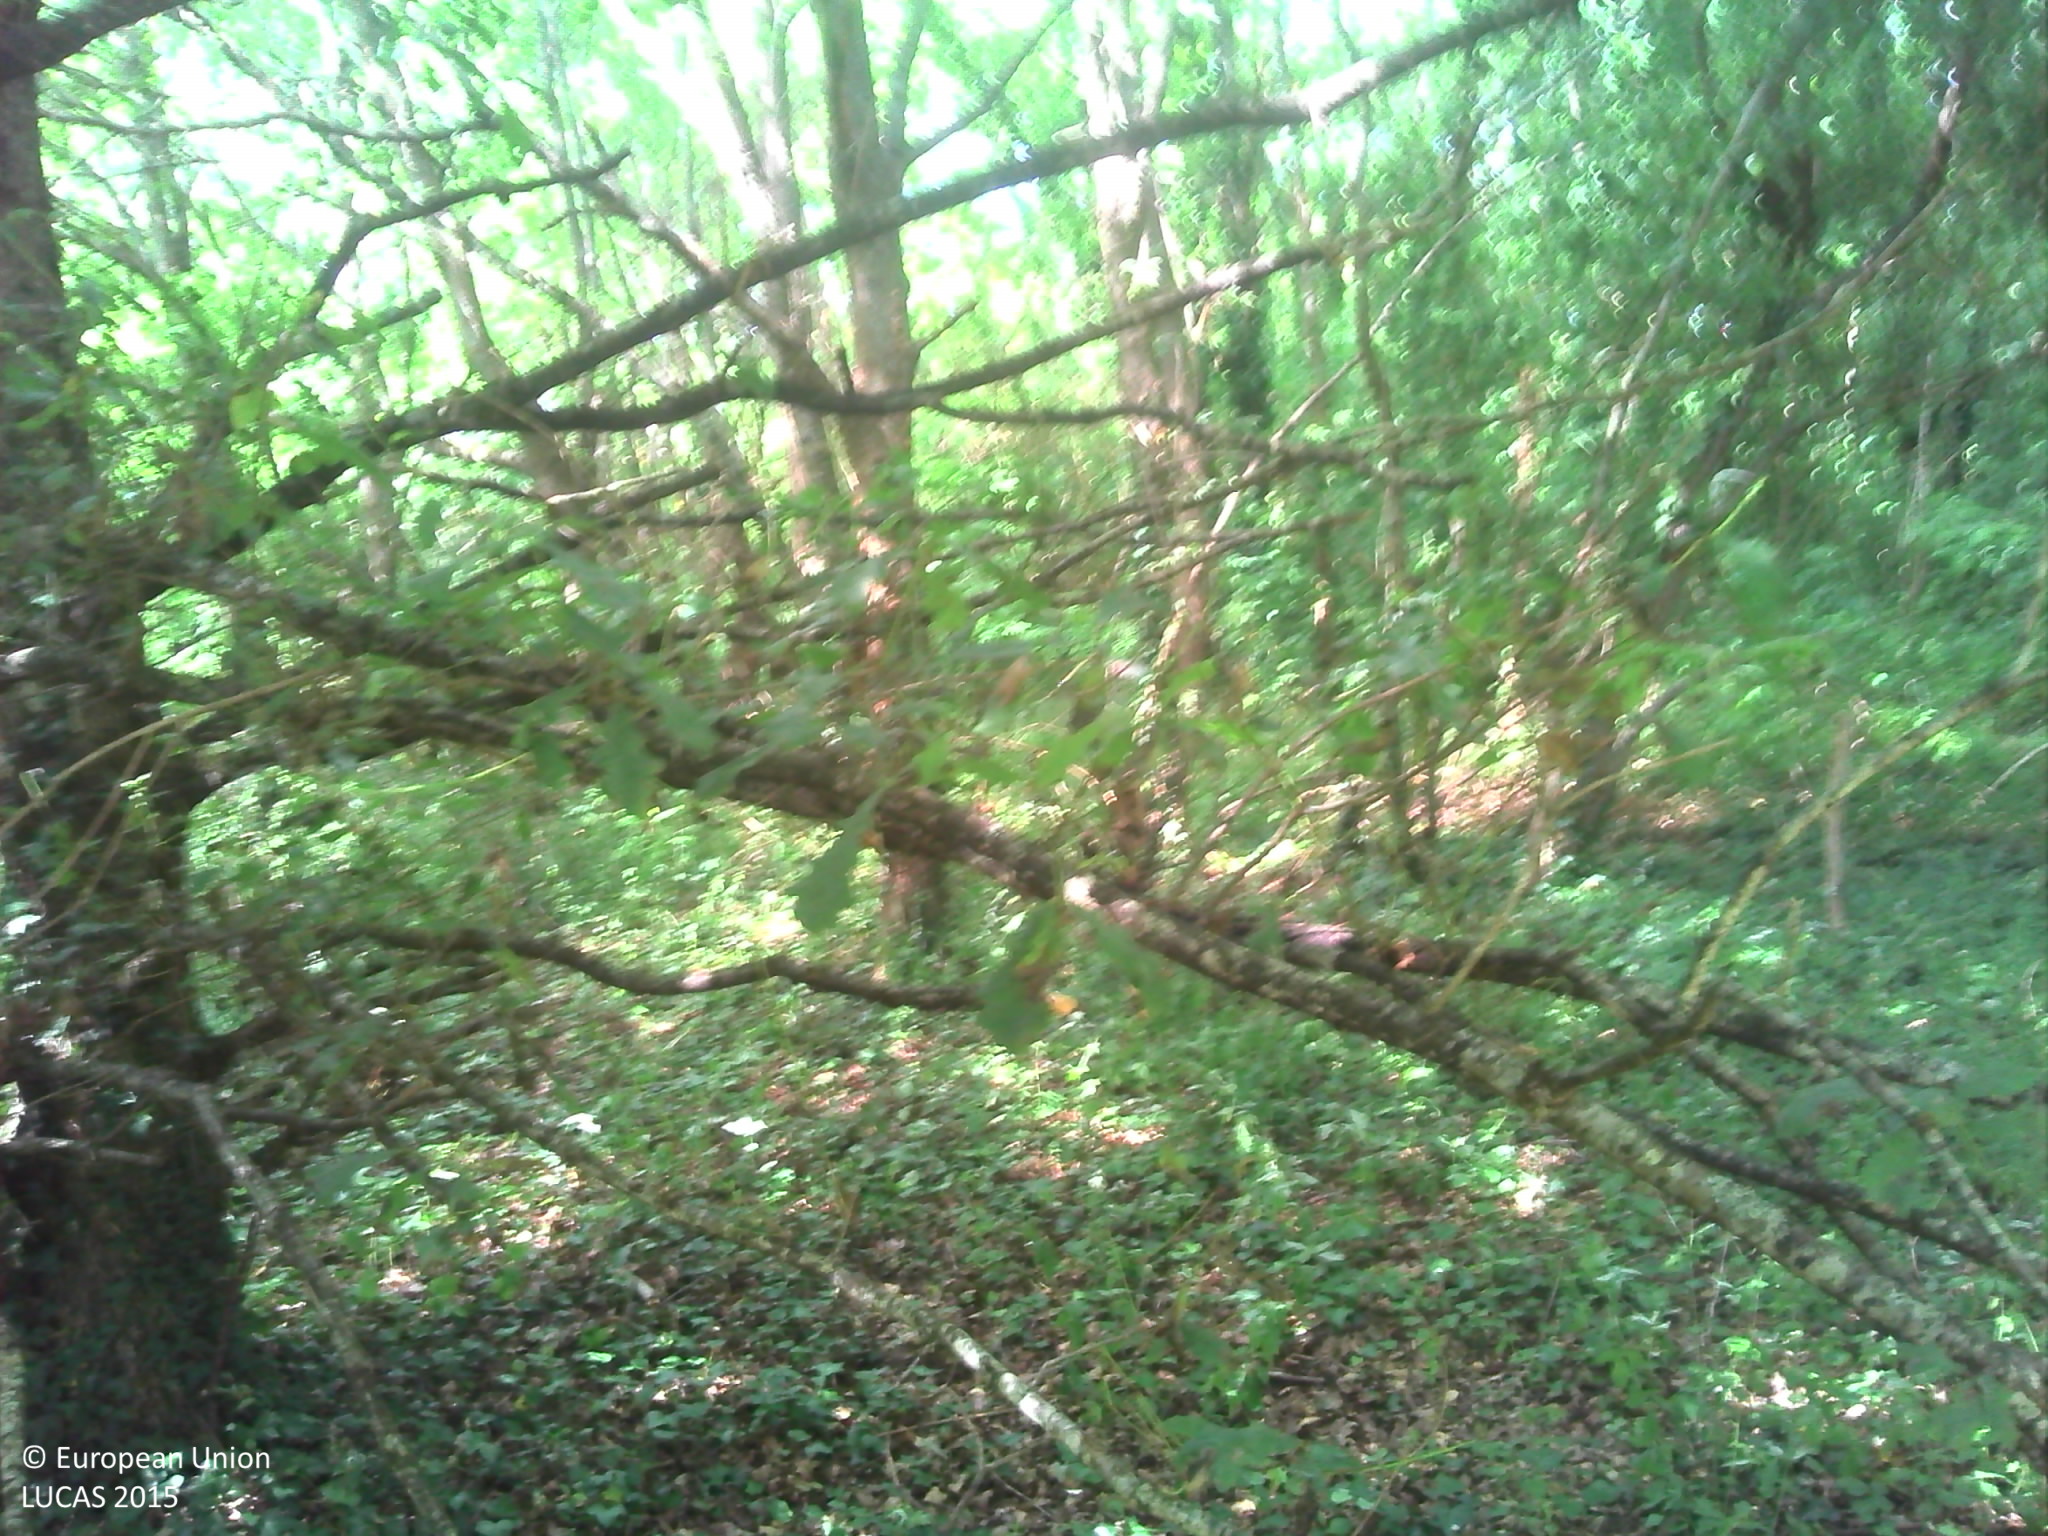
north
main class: Woodland
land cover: Broadleaved woodland
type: mesophytic deciduous forest
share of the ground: > 75 %
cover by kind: herbaceous plants 40 %, unconsolidated bare surface 40 %, broadleaved forest trees 20 %
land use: Forestry
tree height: > 5 m
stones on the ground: < 10 %
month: June
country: FR
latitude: 47.4372
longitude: 1.4336
